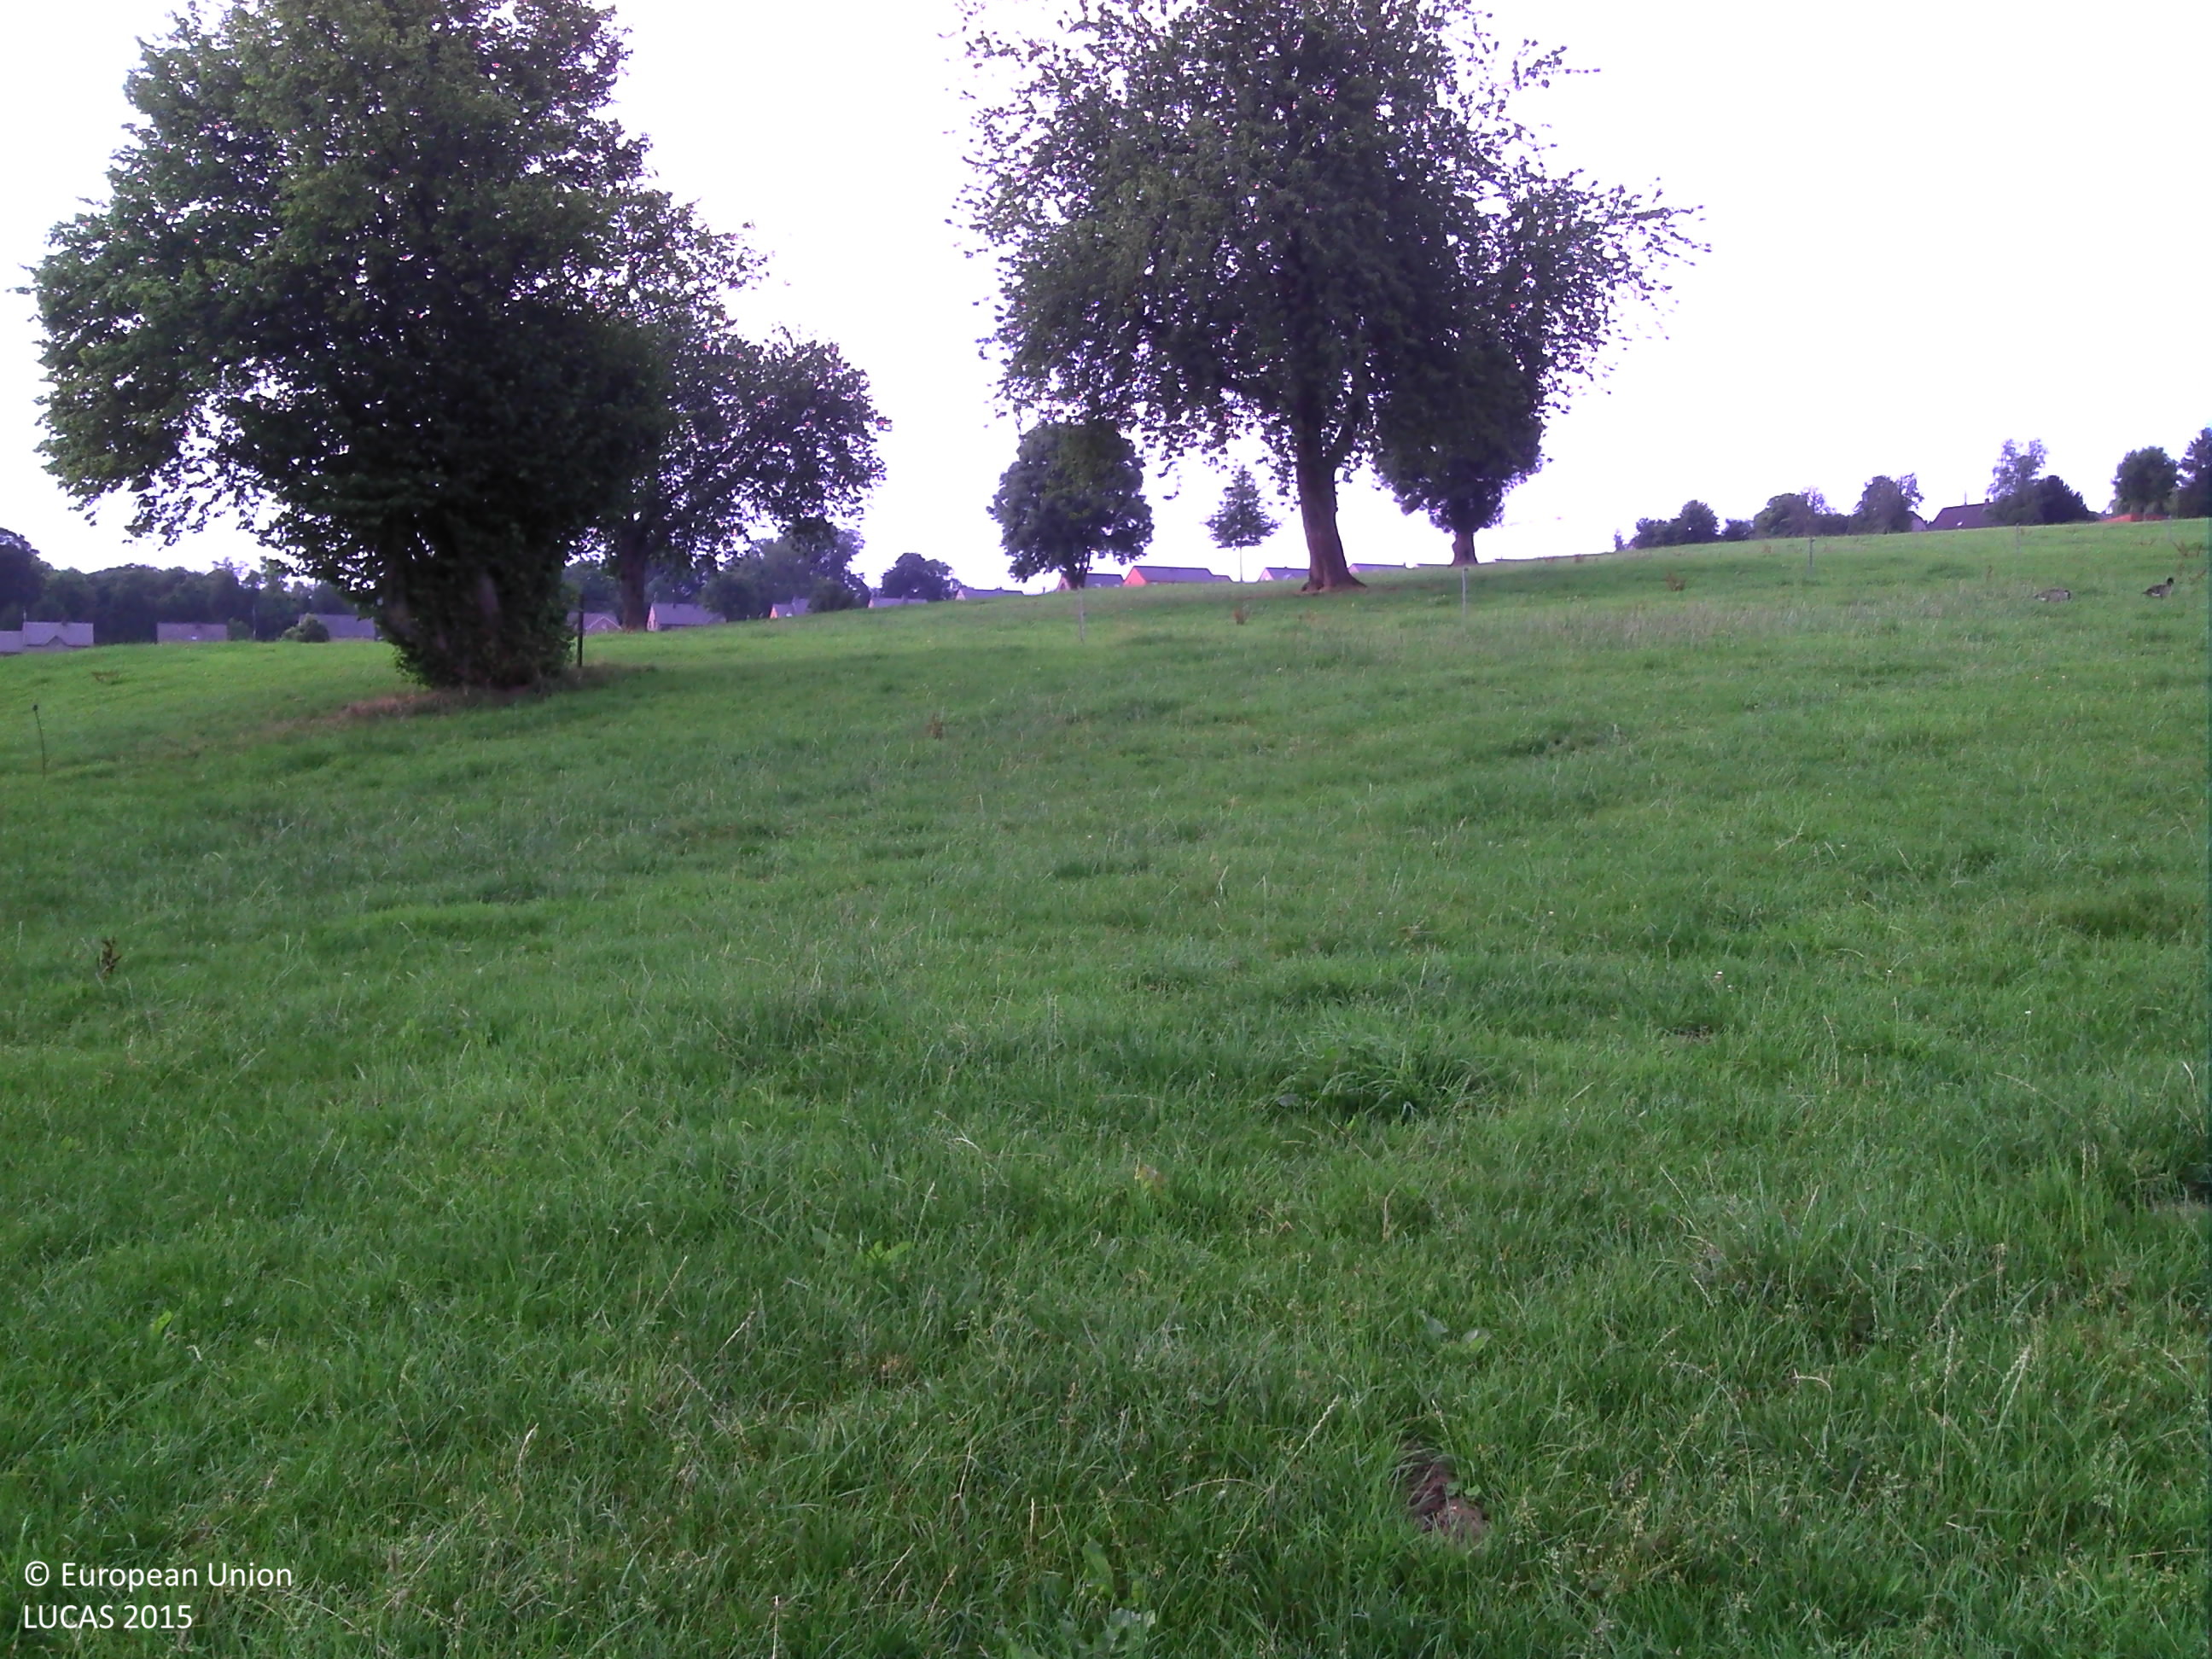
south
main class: Grassland
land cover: Grassland without tree/shrub cover
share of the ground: > 75 %
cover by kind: herbaceous plants 100 %
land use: Agriculture (excluding fallow land and kitchen gardens)
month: July
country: BE
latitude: 50.6449
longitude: 5.7419
